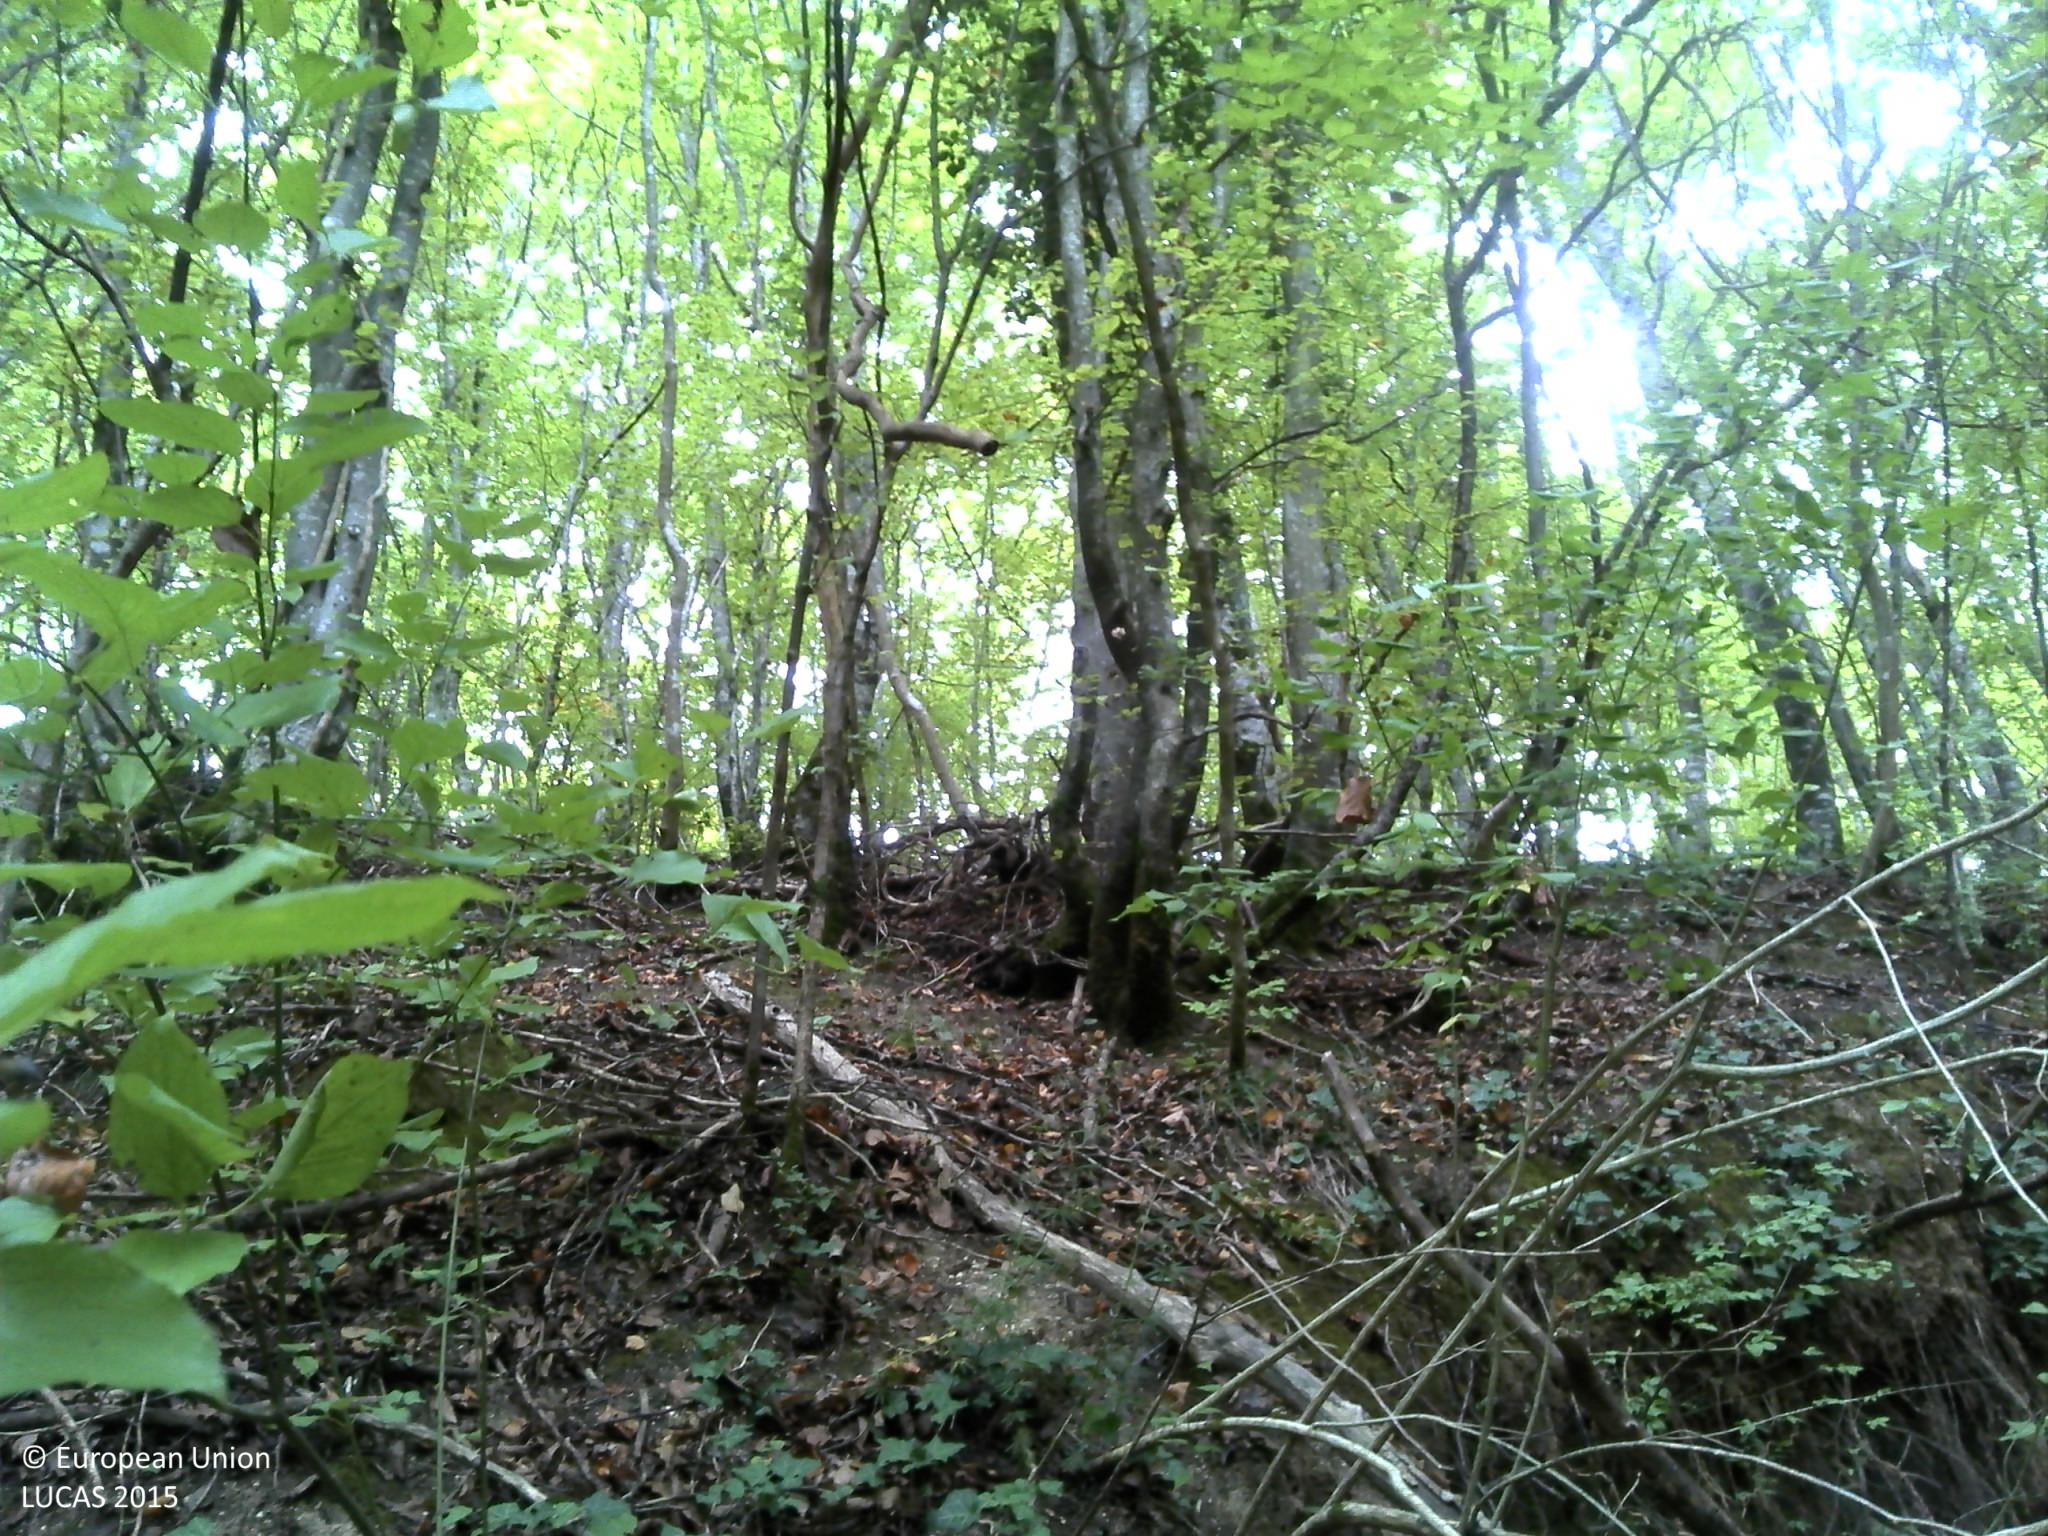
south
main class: Woodland
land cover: Broadleaved woodland
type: beech forest
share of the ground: > 75 %
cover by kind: broadleaved forest trees 100 %
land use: Forestry
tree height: > 5 m
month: September
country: HR
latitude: 45.2107
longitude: 15.6106
